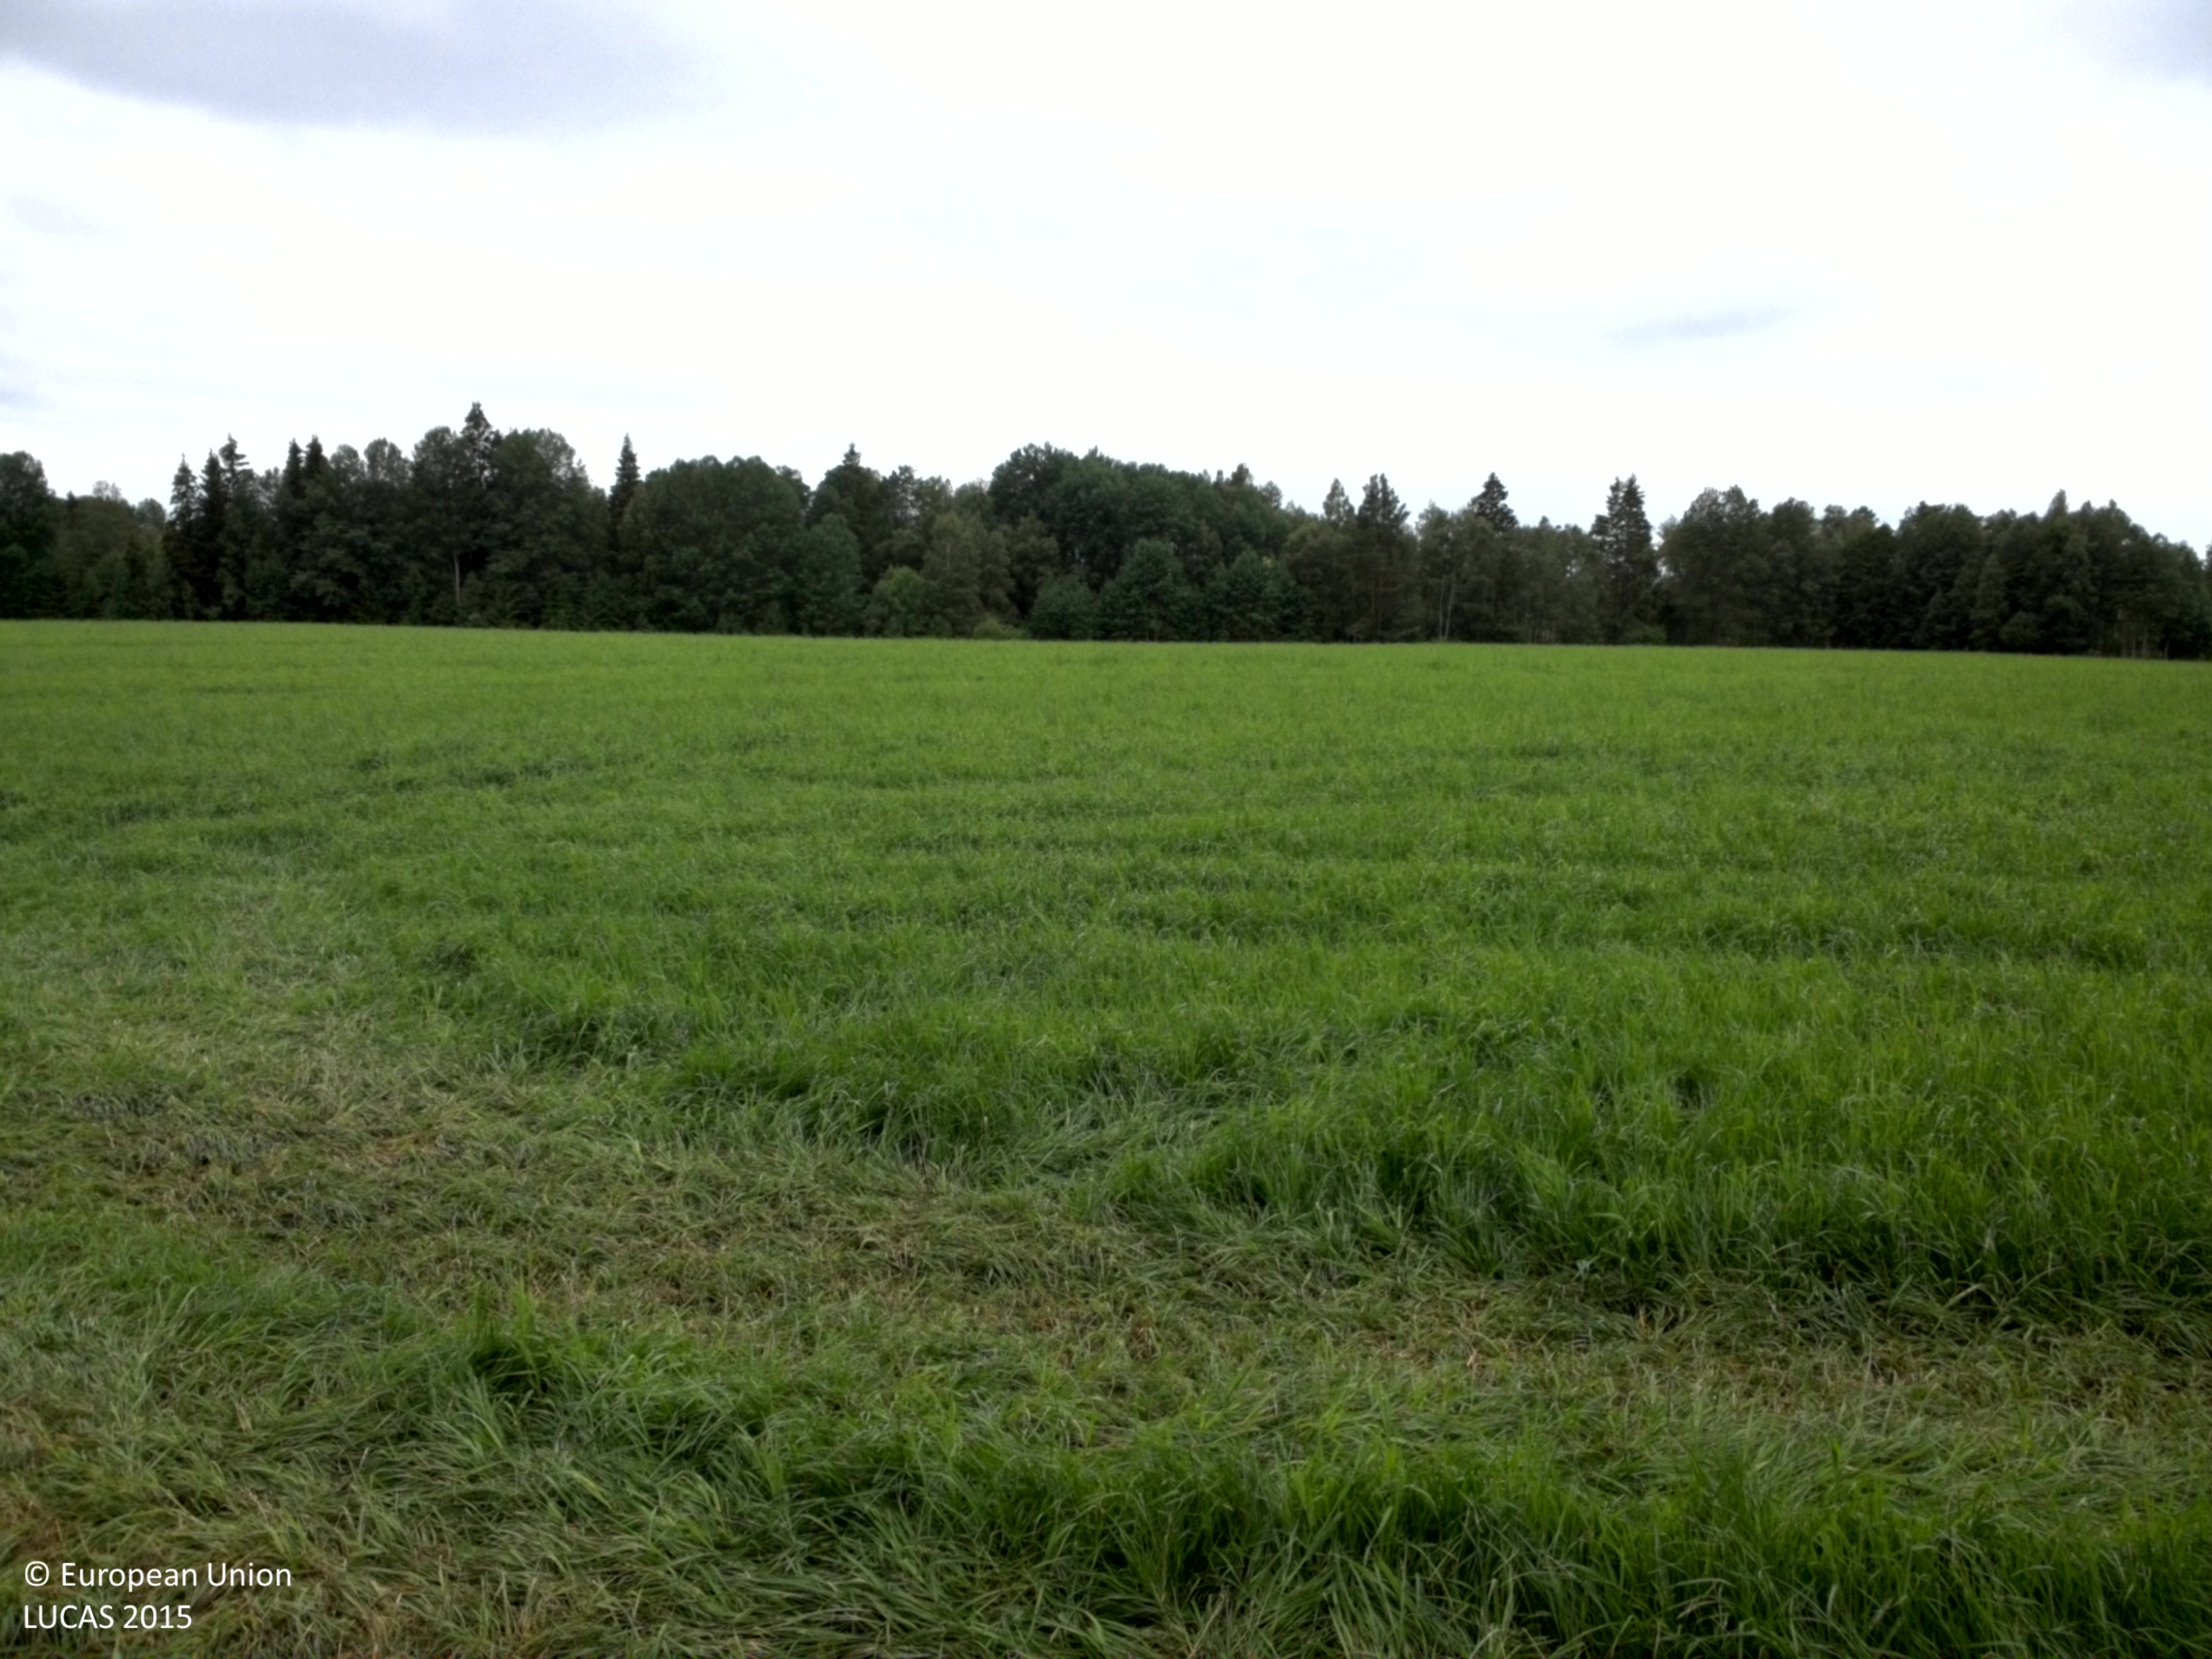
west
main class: Cropland
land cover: Temporary grasslands
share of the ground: > 75 %
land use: Agriculture (excluding fallow land and kitchen gardens)
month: July
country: SE
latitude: 58.1614
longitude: 13.9543
